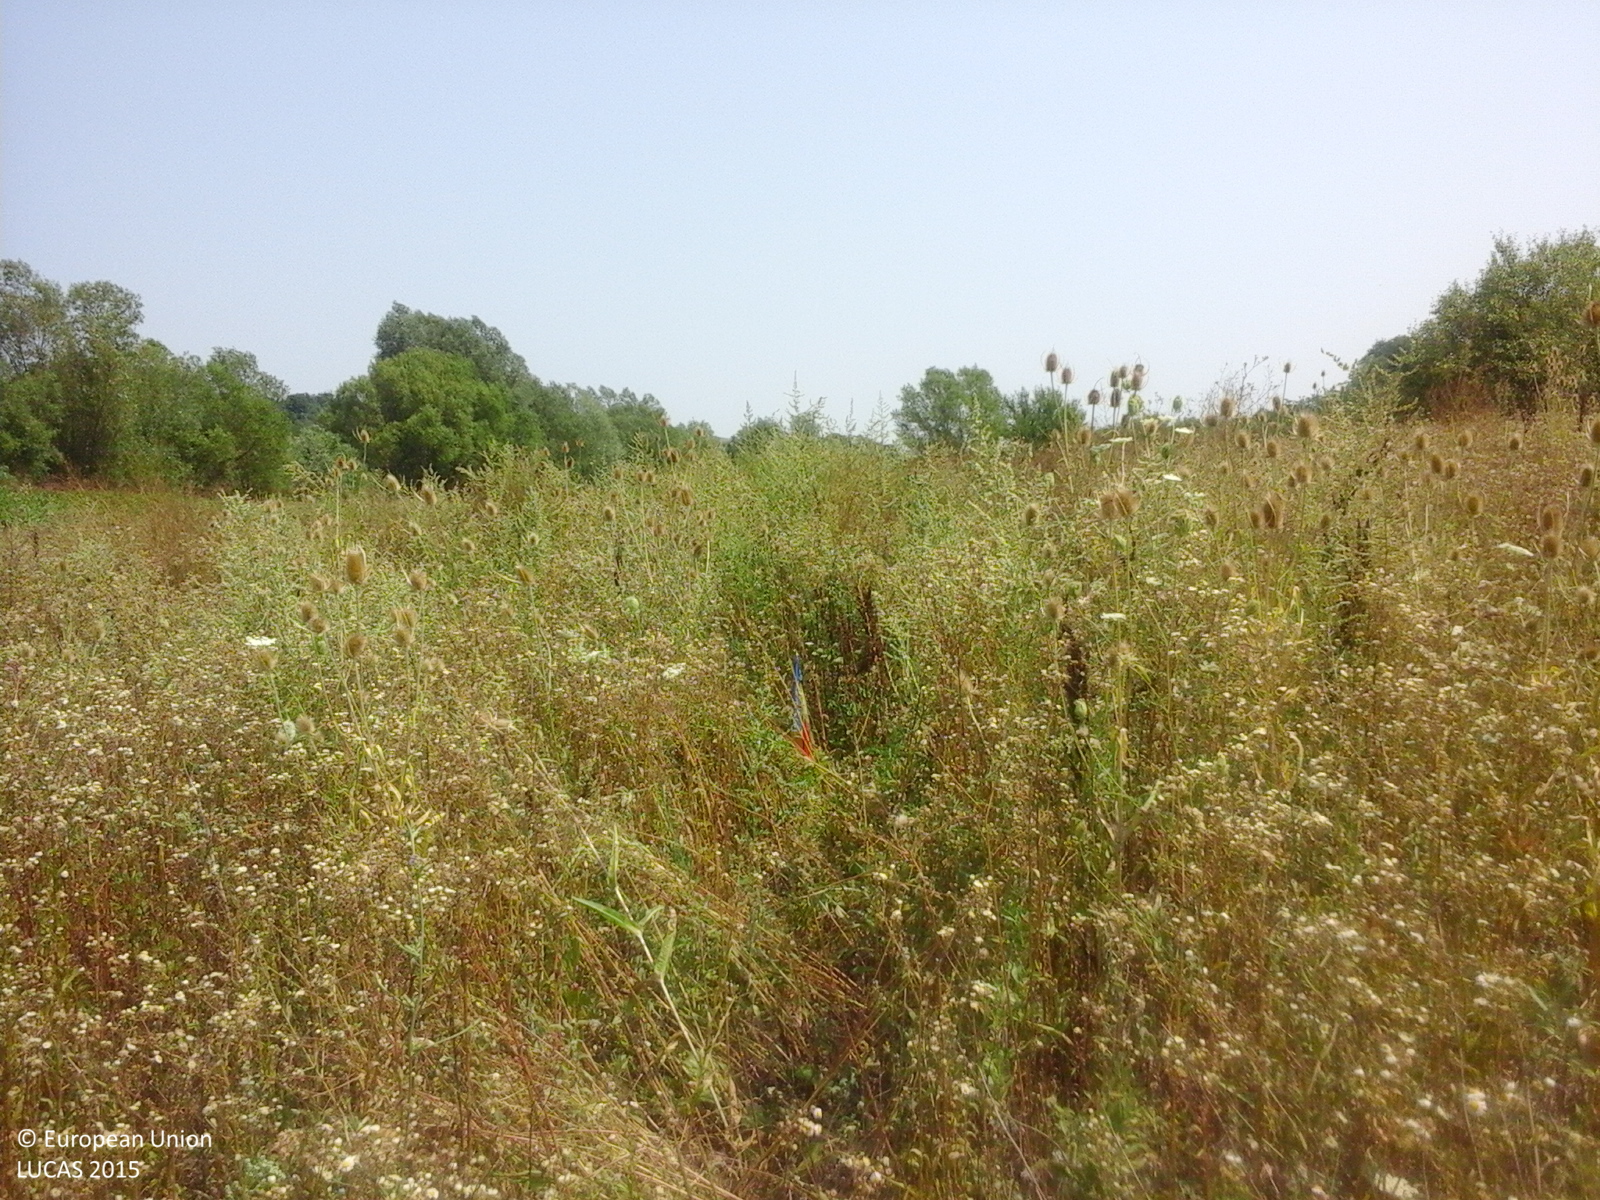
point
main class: Grassland
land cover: Spontaneously vegetated surfaces
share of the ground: > 75 %
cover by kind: herbaceous plants 100 %
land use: Fallow land
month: August
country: RO
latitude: 44.3971
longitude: 23.3456
